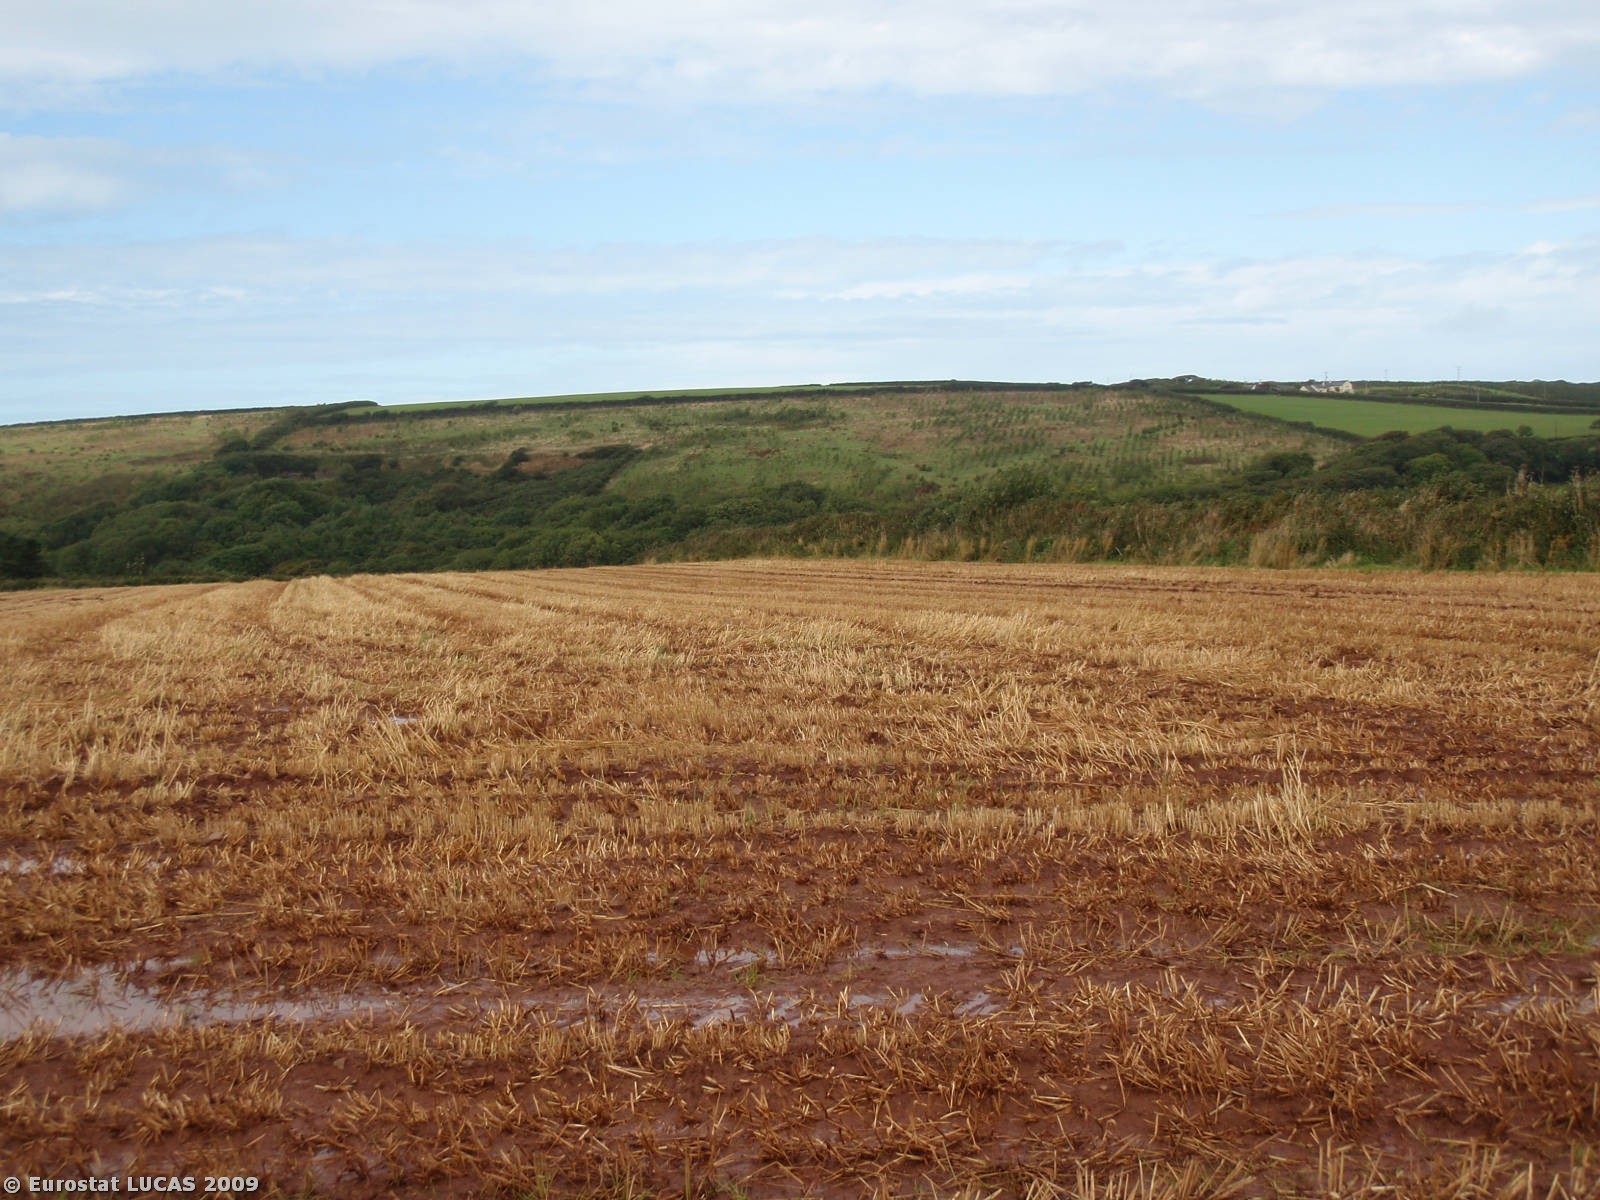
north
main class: Cropland
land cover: Oats
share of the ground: < 10 %
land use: Agriculture (excluding fallow land and kitchen gardens)
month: August
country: GB
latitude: 50.9933
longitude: -4.4513
